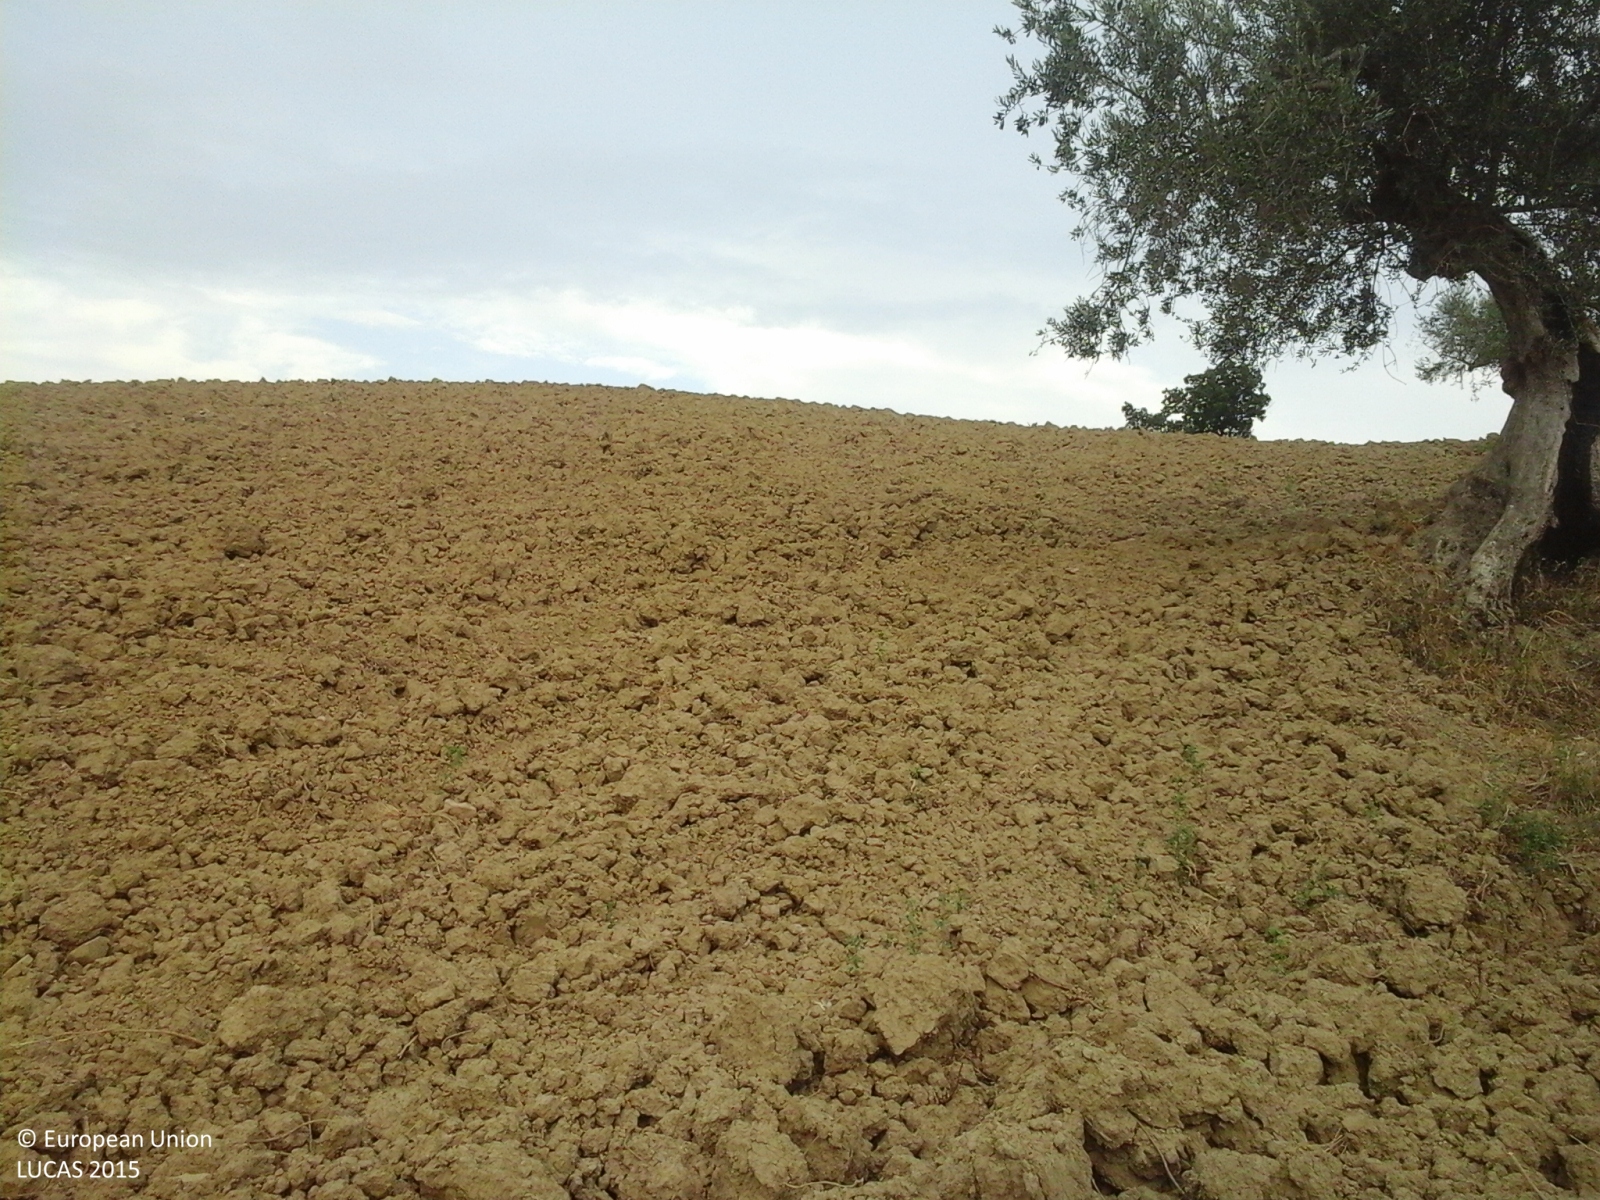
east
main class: Cropland
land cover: Olive groves
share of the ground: 25 - 50 %
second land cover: Spontaneously vegetated surfaces
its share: 25 - 50 %
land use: Agriculture (excluding fallow land and kitchen gardens)
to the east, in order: Olive groves; Spontaneously vegetated surfaces; Other bare soil; Abandoned hedges; Grass margins; Paved roads, cycling and walking lanes; Fences; Grass margins; Grassland without tree/shrub cover; Broadleaved woodland; Fences; Tracks; Other cereals; Electric lines; Other cereals; Dry pulses
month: August
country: IT
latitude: 42.5087
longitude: 13.8464
